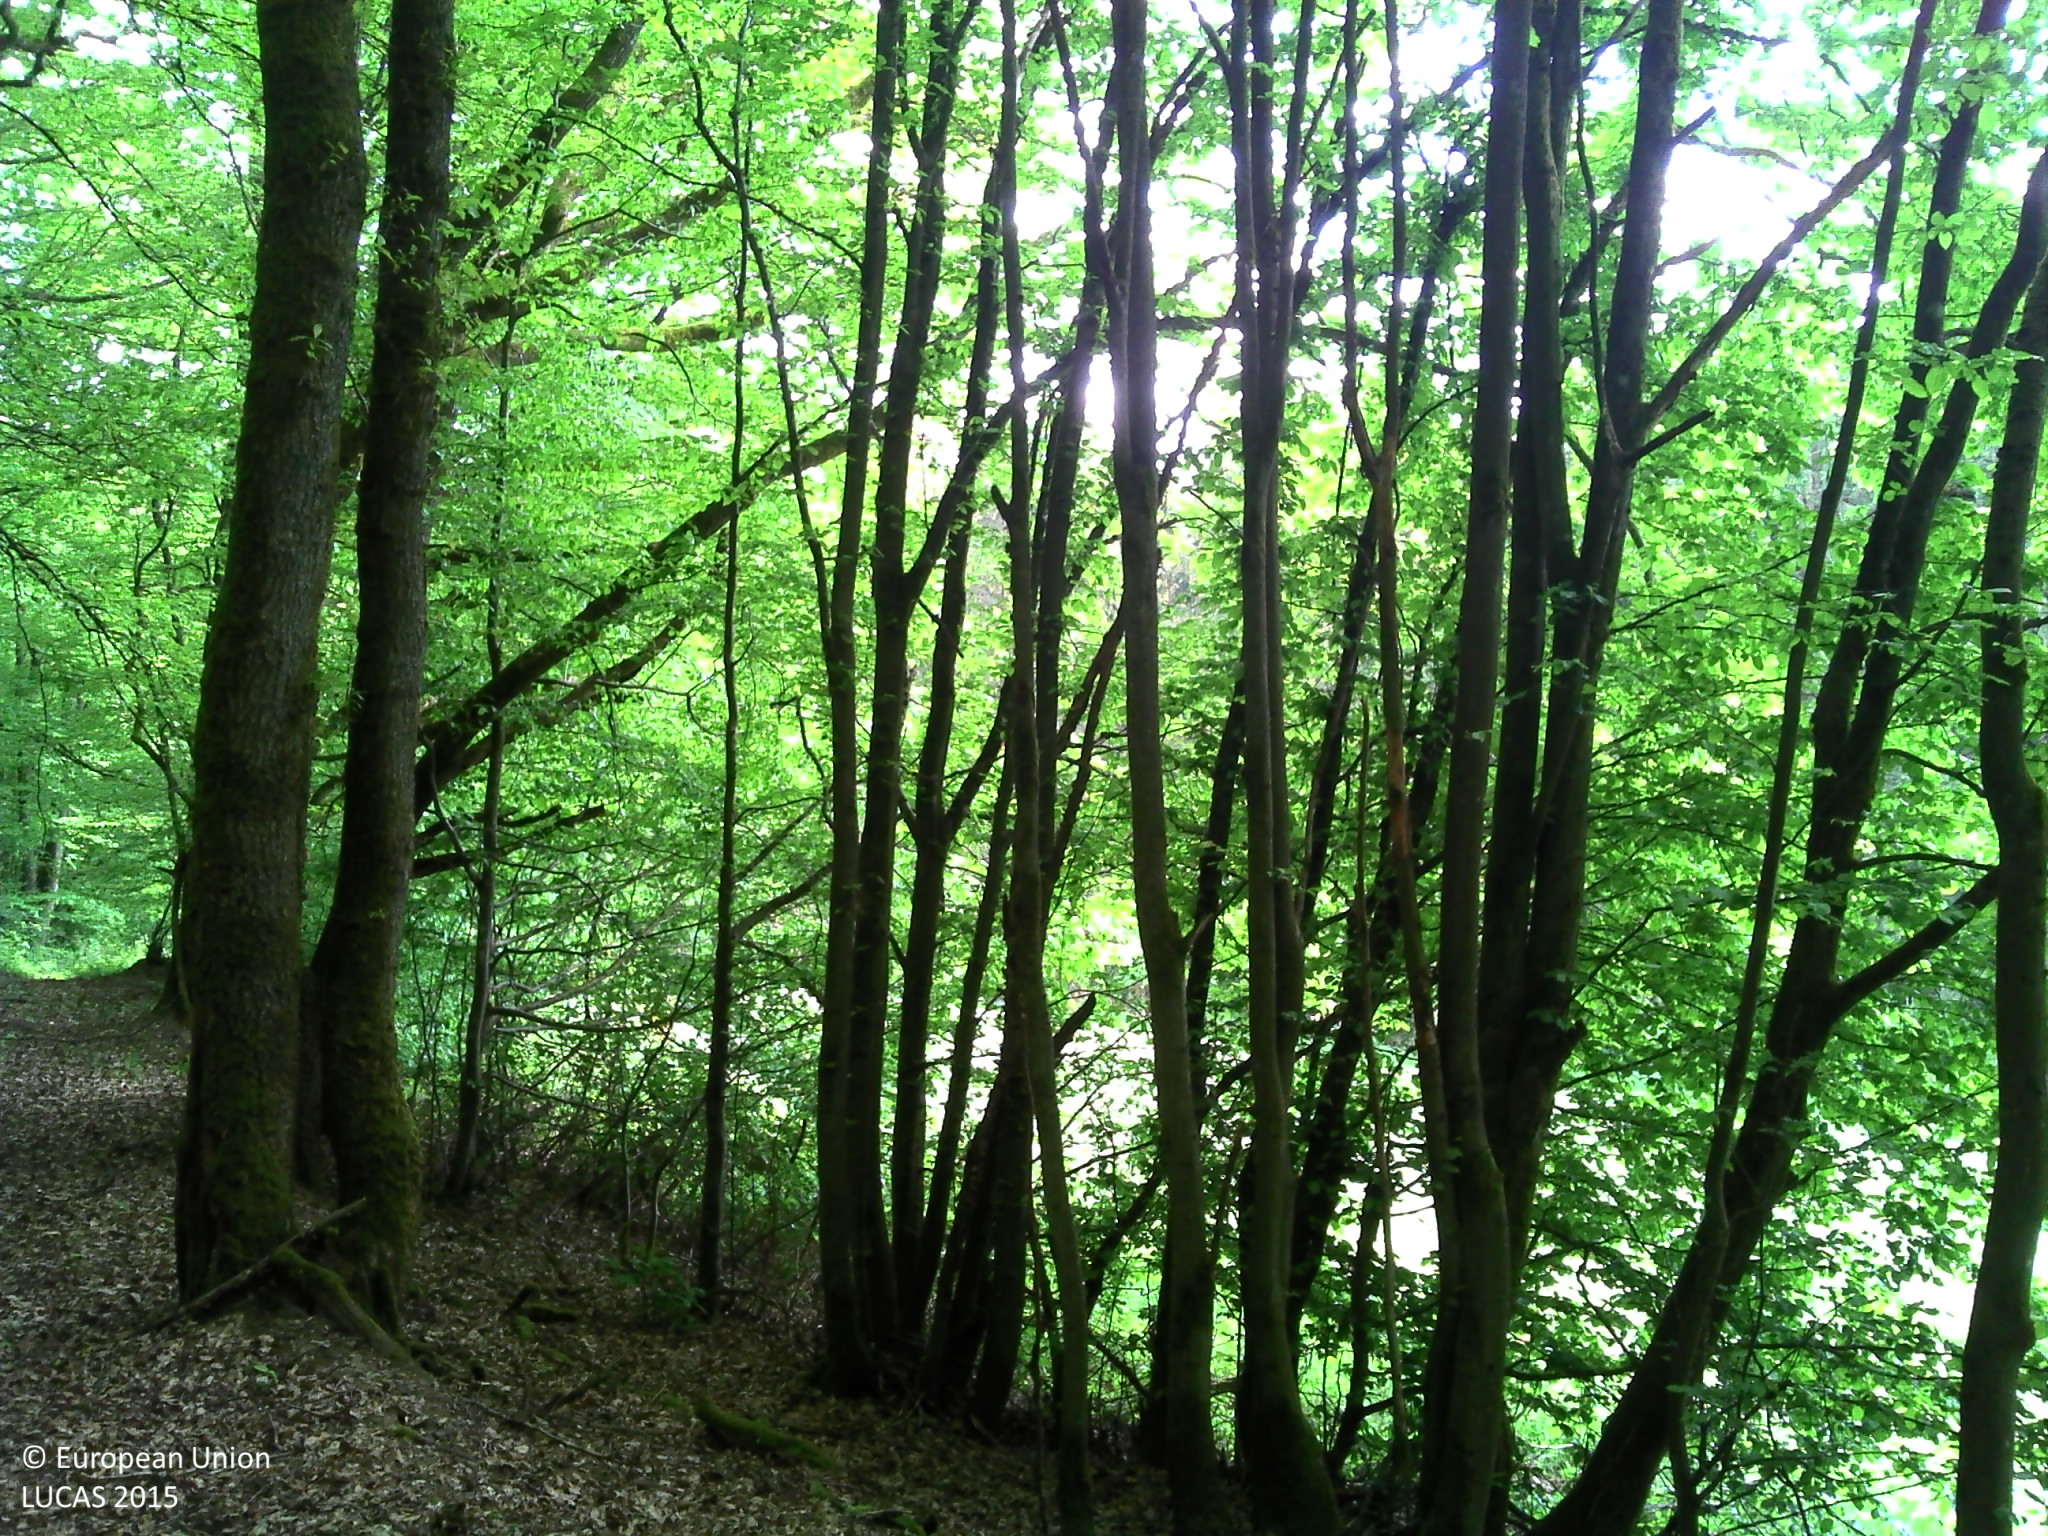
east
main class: Woodland
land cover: Broadleaved woodland
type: beech forest
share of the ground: > 75 %
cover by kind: broadleaved forest trees 90 %, lichens and mosses 10 %
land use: Forestry
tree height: > 5 m
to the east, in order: Broadleaved woodland; Temporary grasslands; Spruce dominated coniferous woodland; Ditches and canals; Grass margins; Tracks; Grass margins; Other bare soil; Spruce dominated coniferous woodland; Rivers and streams; Spruce dominated coniferous woodland
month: May
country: LU
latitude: 49.9830
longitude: 5.8569
